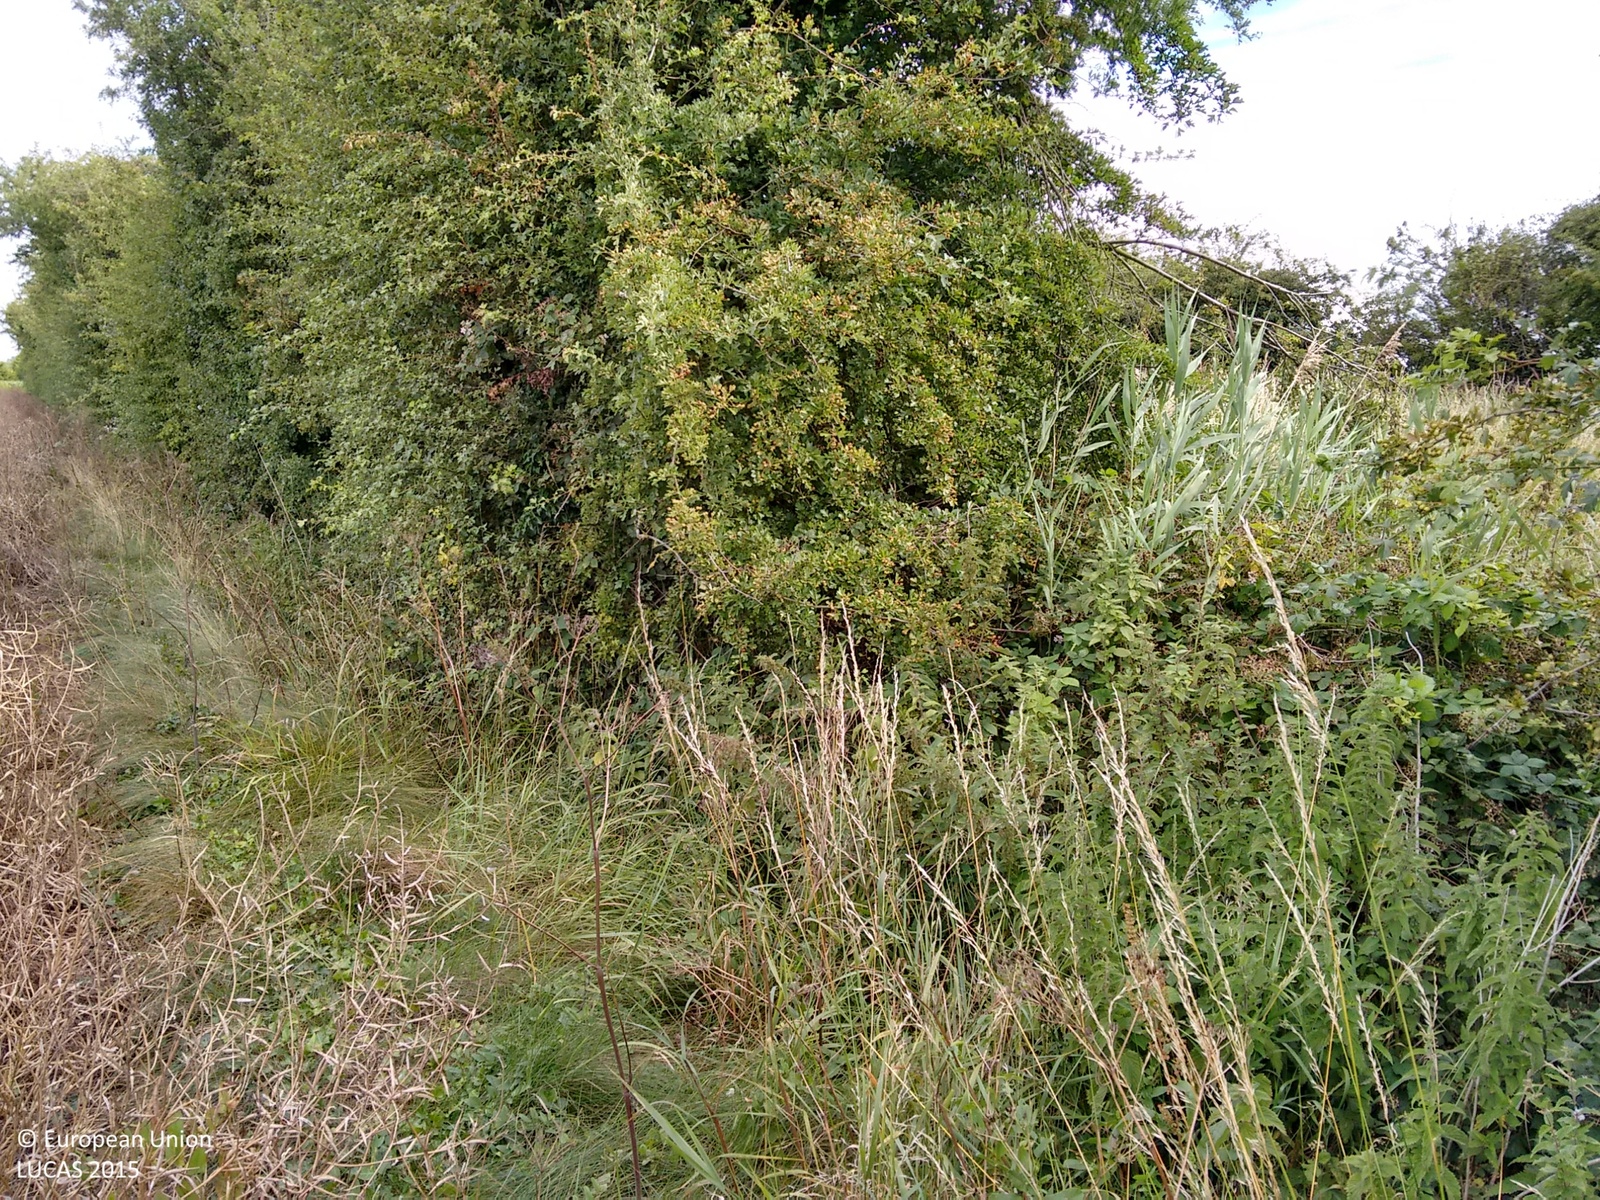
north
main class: Cropland
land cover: Rape and turnip rape
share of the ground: > 75 %
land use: Agriculture (excluding fallow land and kitchen gardens)
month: August
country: GB
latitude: 52.7601
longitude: 0.3241
